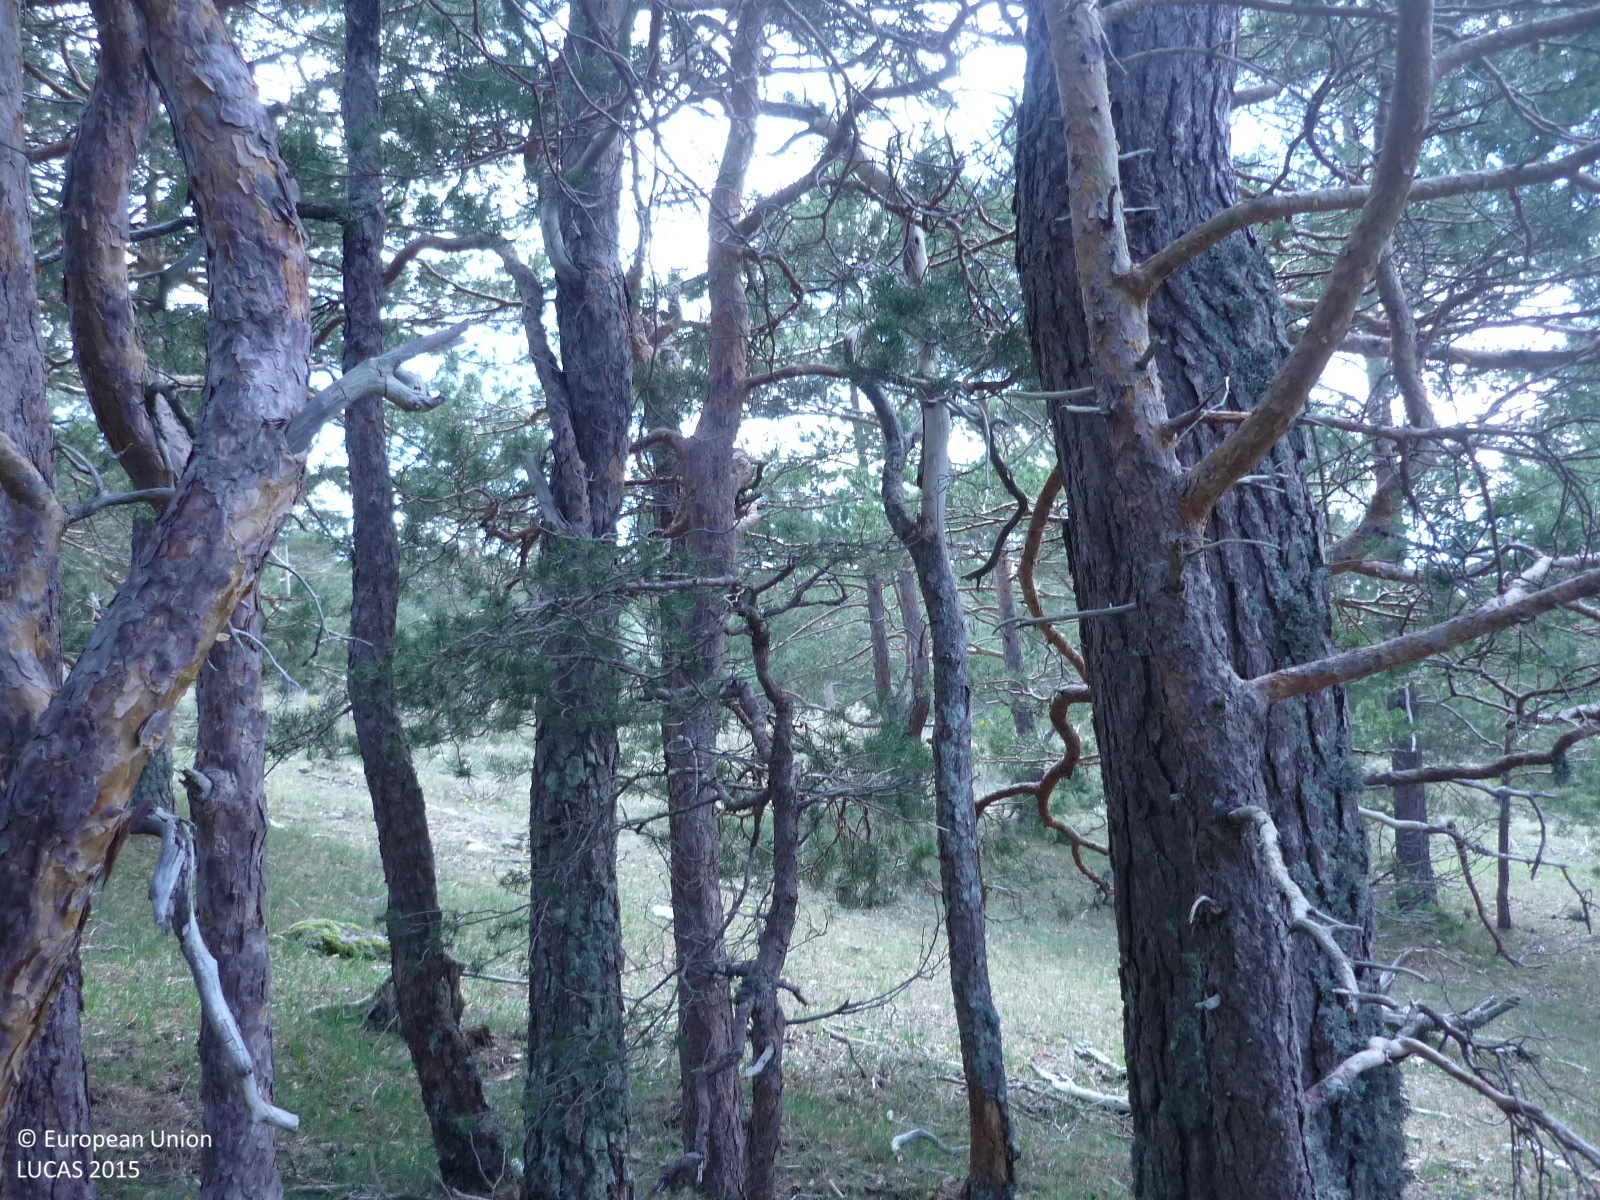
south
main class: Woodland
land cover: Pine dominated coniferous woodland
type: coniferous forest of the mediterranean region
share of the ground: > 75 %
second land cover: Grassland without tree/shrub cover
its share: > 75 %
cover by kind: coniferous forest trees 80 %, shrubs 10 %, herbaceous plants 10 %
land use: Forestry
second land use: Agriculture (excluding fallow land and kitchen gardens)
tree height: > 5 m
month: May
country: ES
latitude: 40.8466
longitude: -3.9115
